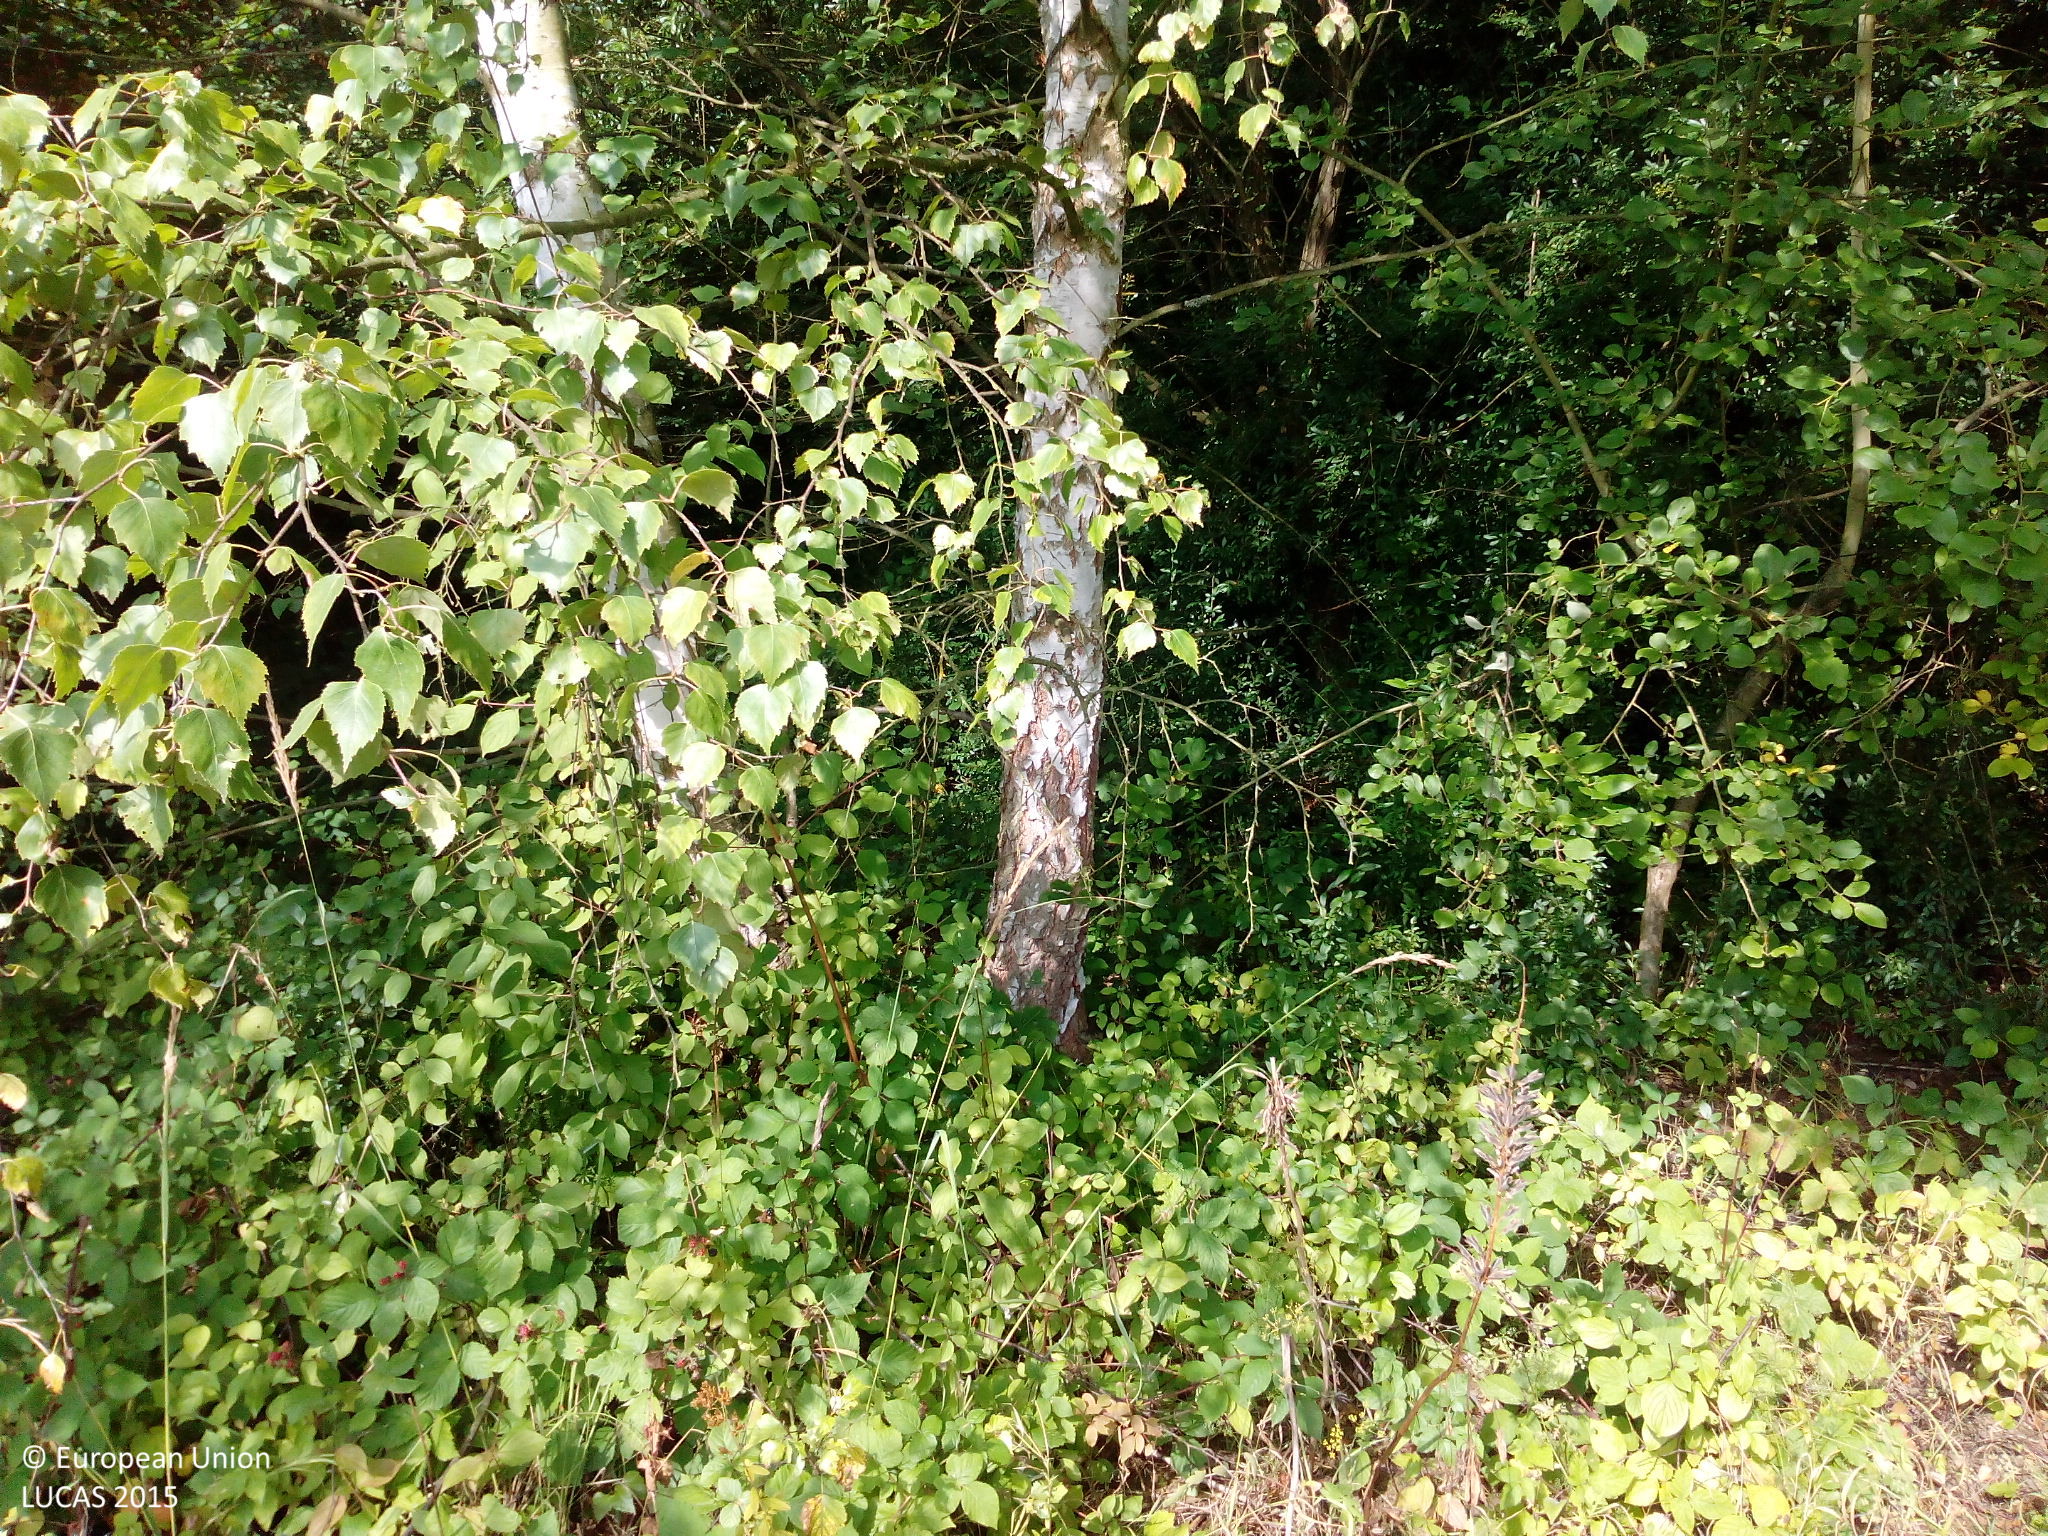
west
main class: Woodland
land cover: Broadleaved woodland
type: acidophilous oak and oak-birch forest
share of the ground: 25 - 50 %
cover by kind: herbaceous plants 50 %, broadleaved forest trees 40 %, shrubs 10 %
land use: Semi-natural and natural areas not in use
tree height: > 5 m
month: August
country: DE
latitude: 50.3370
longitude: 7.5134
